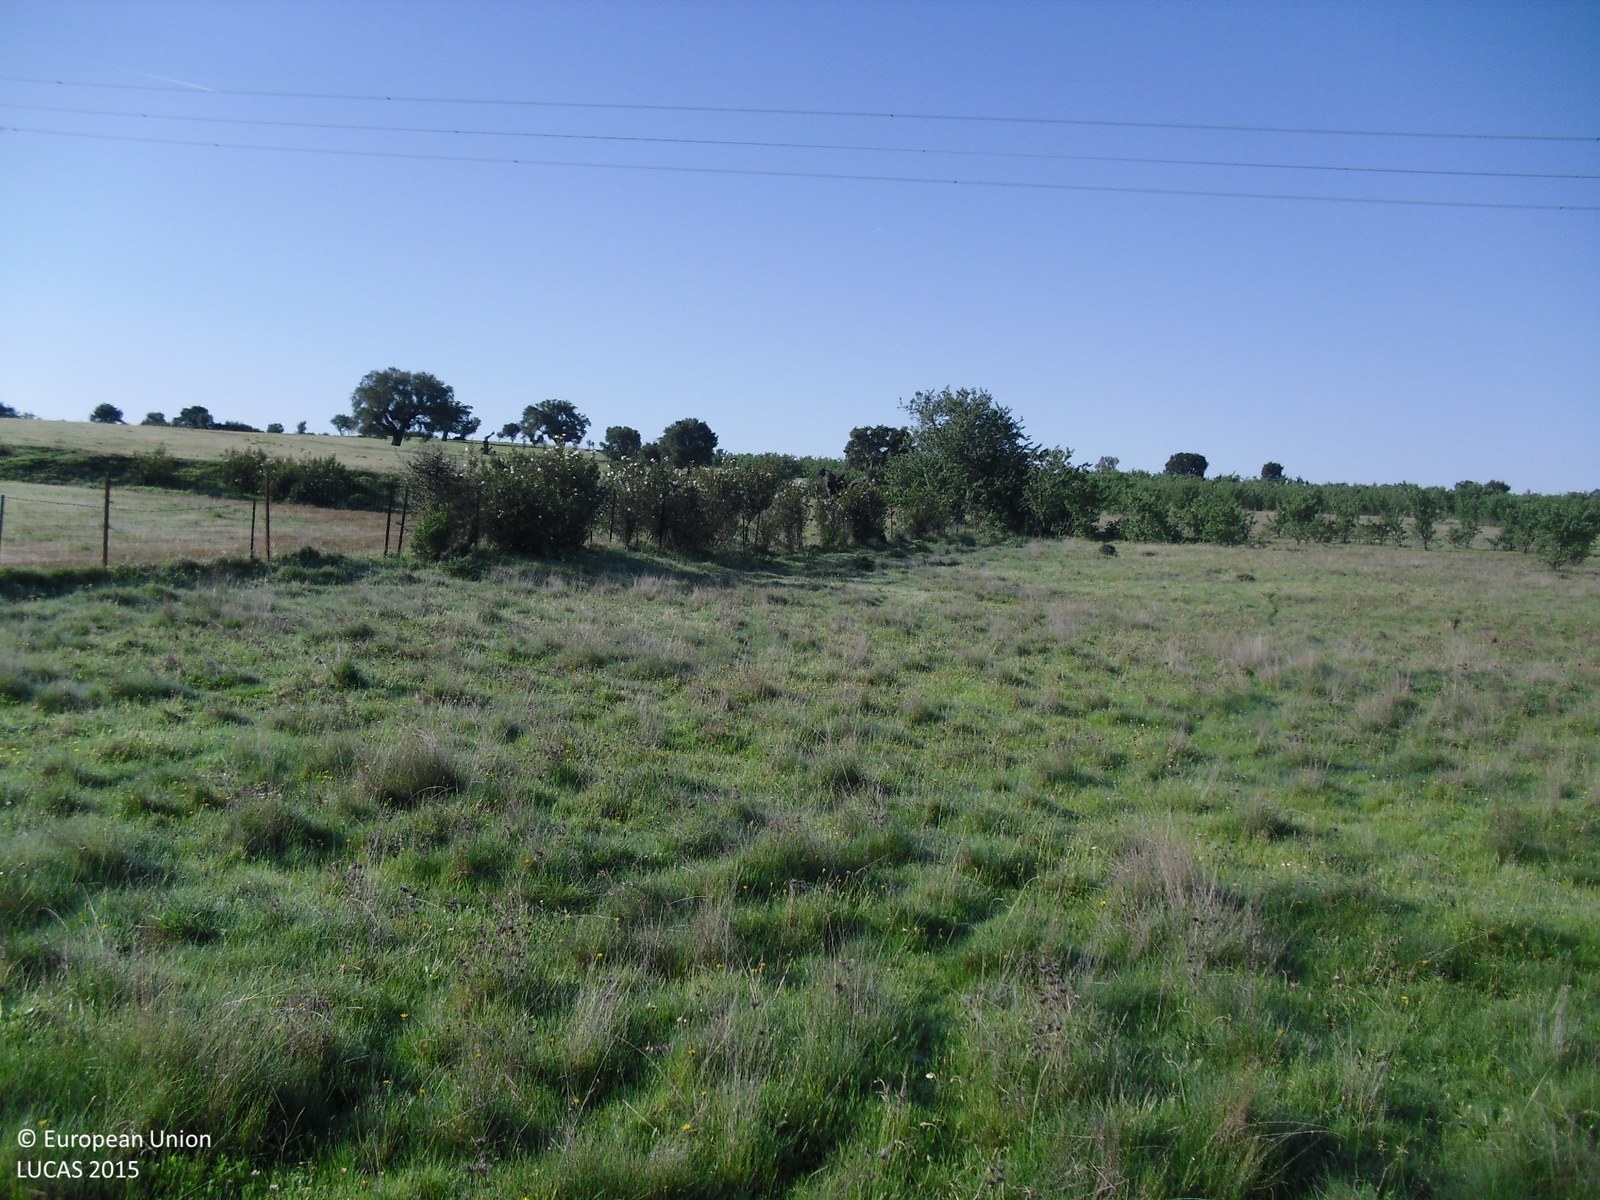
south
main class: Grassland
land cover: Grassland with sparse tree/shrub cover
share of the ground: > 75 %
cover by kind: herbaceous plants 90 %, broadleaved forest trees 5 %, shrubs 5 %
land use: Agriculture (excluding fallow land and kitchen gardens)
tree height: < 5 m
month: April
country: ES
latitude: 39.6284
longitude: -7.4656
